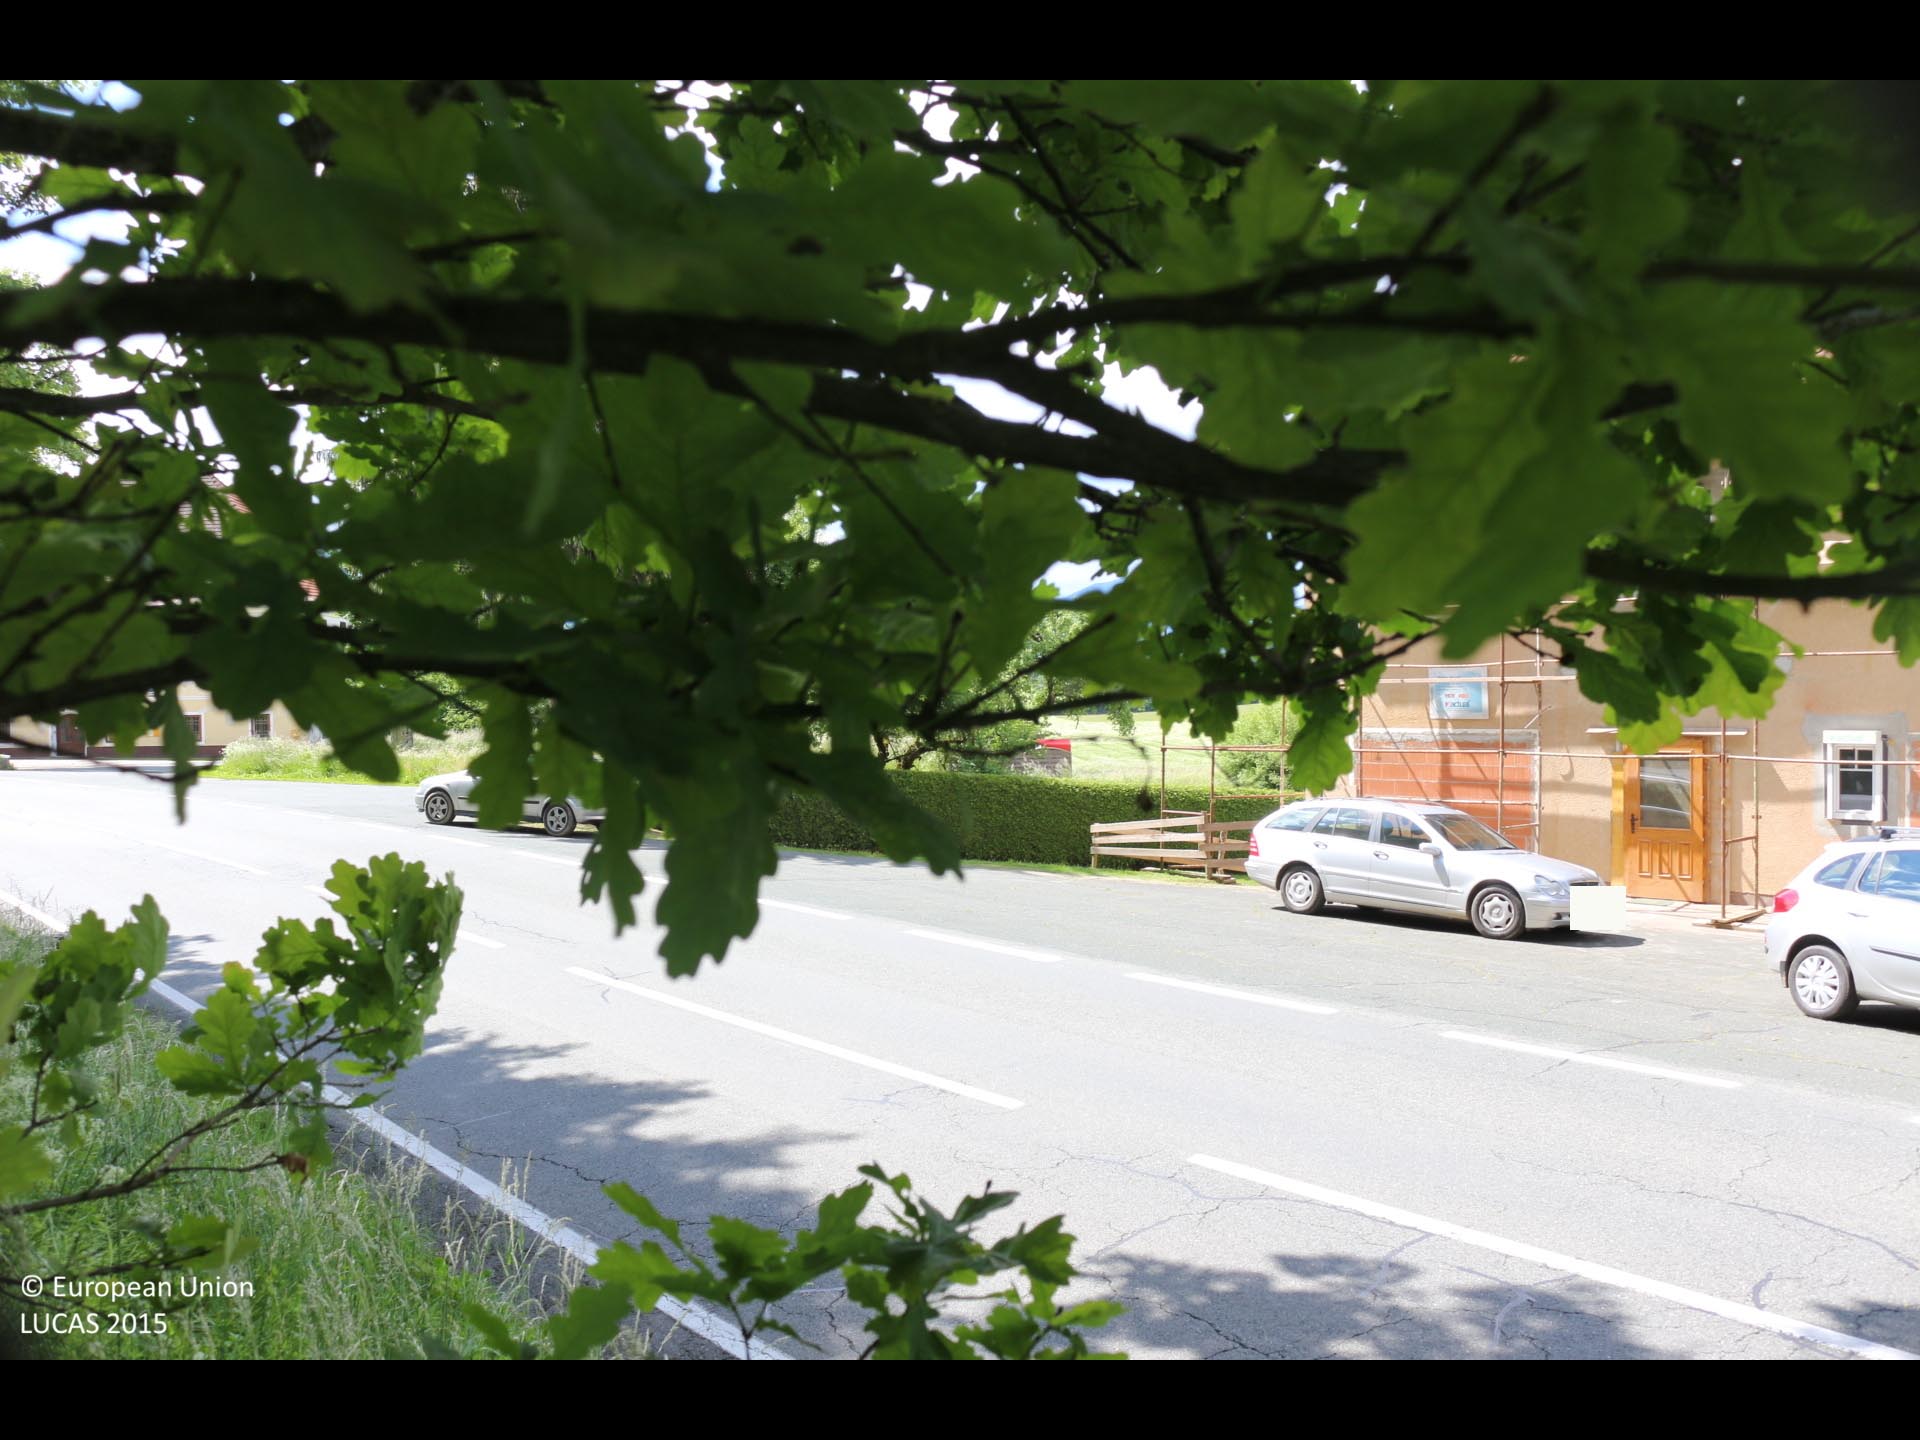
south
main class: Woodland
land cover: Broadleaved woodland
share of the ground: > 75 %
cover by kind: broadleaved forest trees 80 %, shrubs 20 %
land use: Forestry
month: May
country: AT
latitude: 46.6621
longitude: 14.7158
